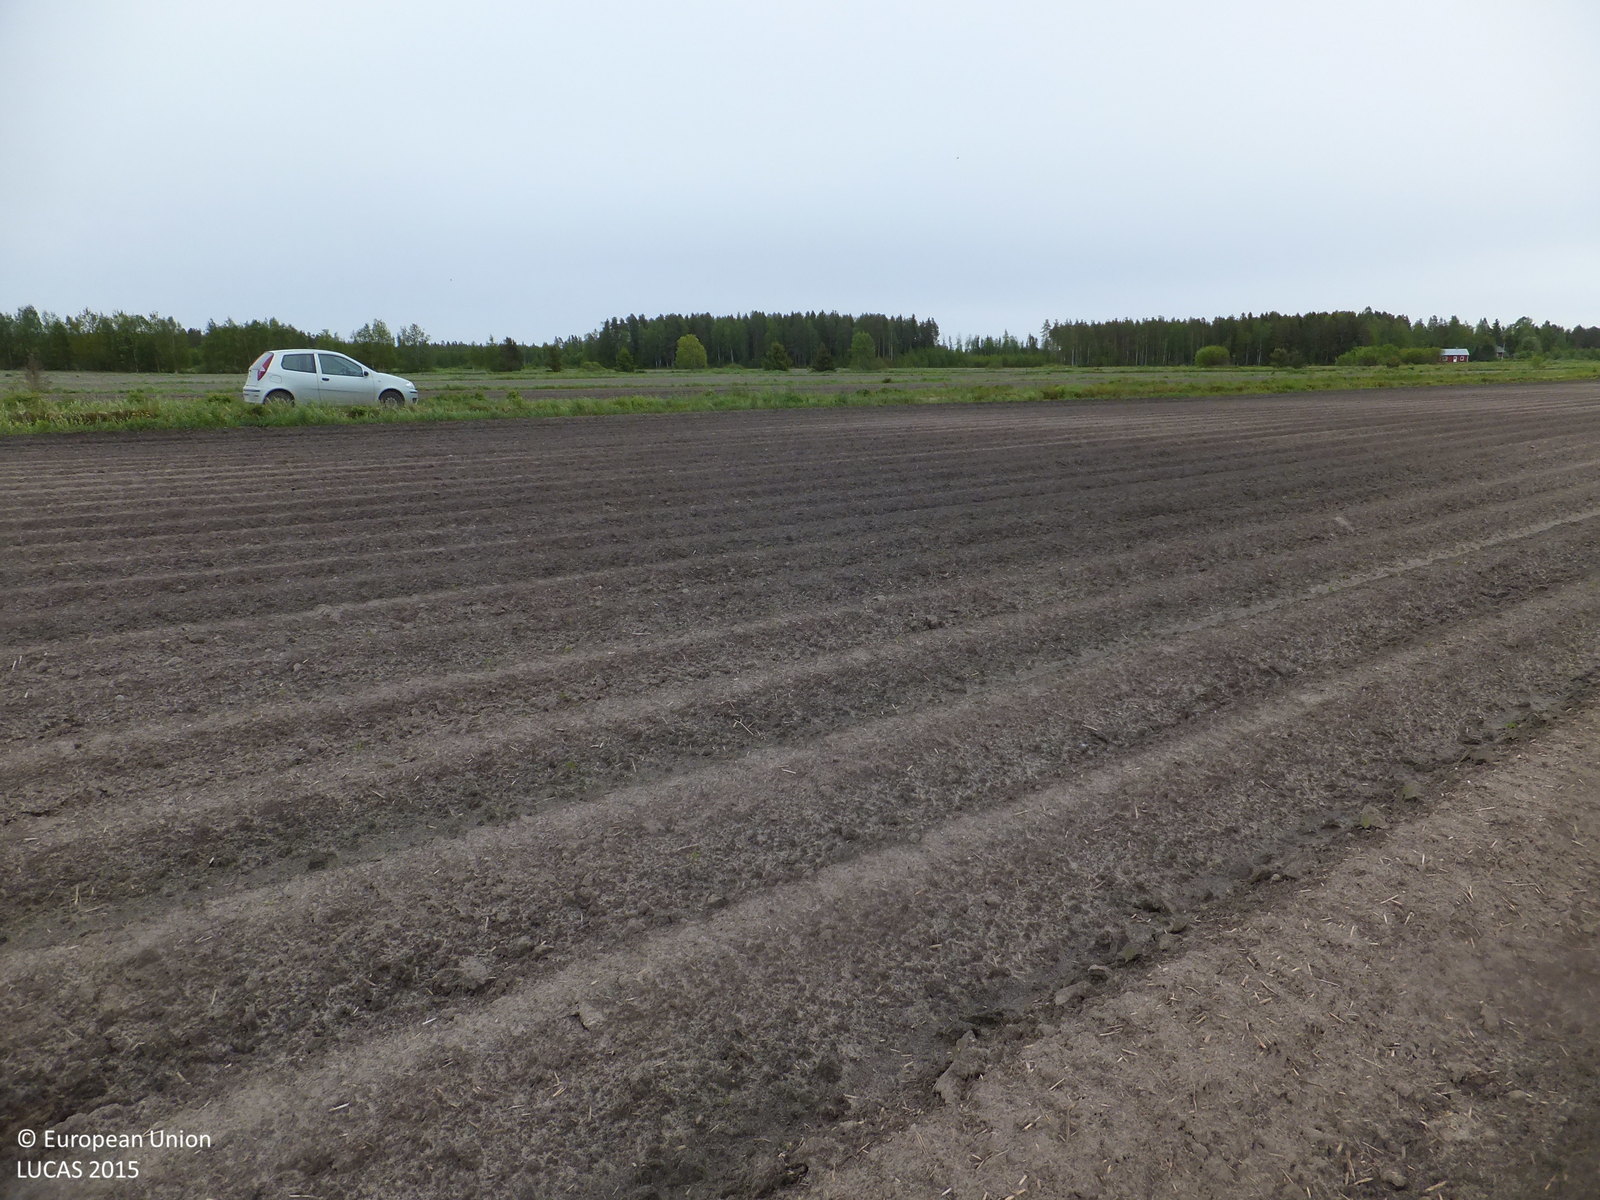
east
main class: Cropland
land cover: Potatoes
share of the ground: < 10 %
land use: Agriculture (excluding fallow land and kitchen gardens)
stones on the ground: < 10 %
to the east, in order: Potatoes; Grass margins; Ditches and canals; Grass margins; Tracks; Grass margins; Ditches and canals; Barley; Ditches and canals; Barley; Ditches and canals; Barley; Grass margins; Ditches and canals; Lines of trees; Barley
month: June
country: FI
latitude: 63.2798
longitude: 22.7105
